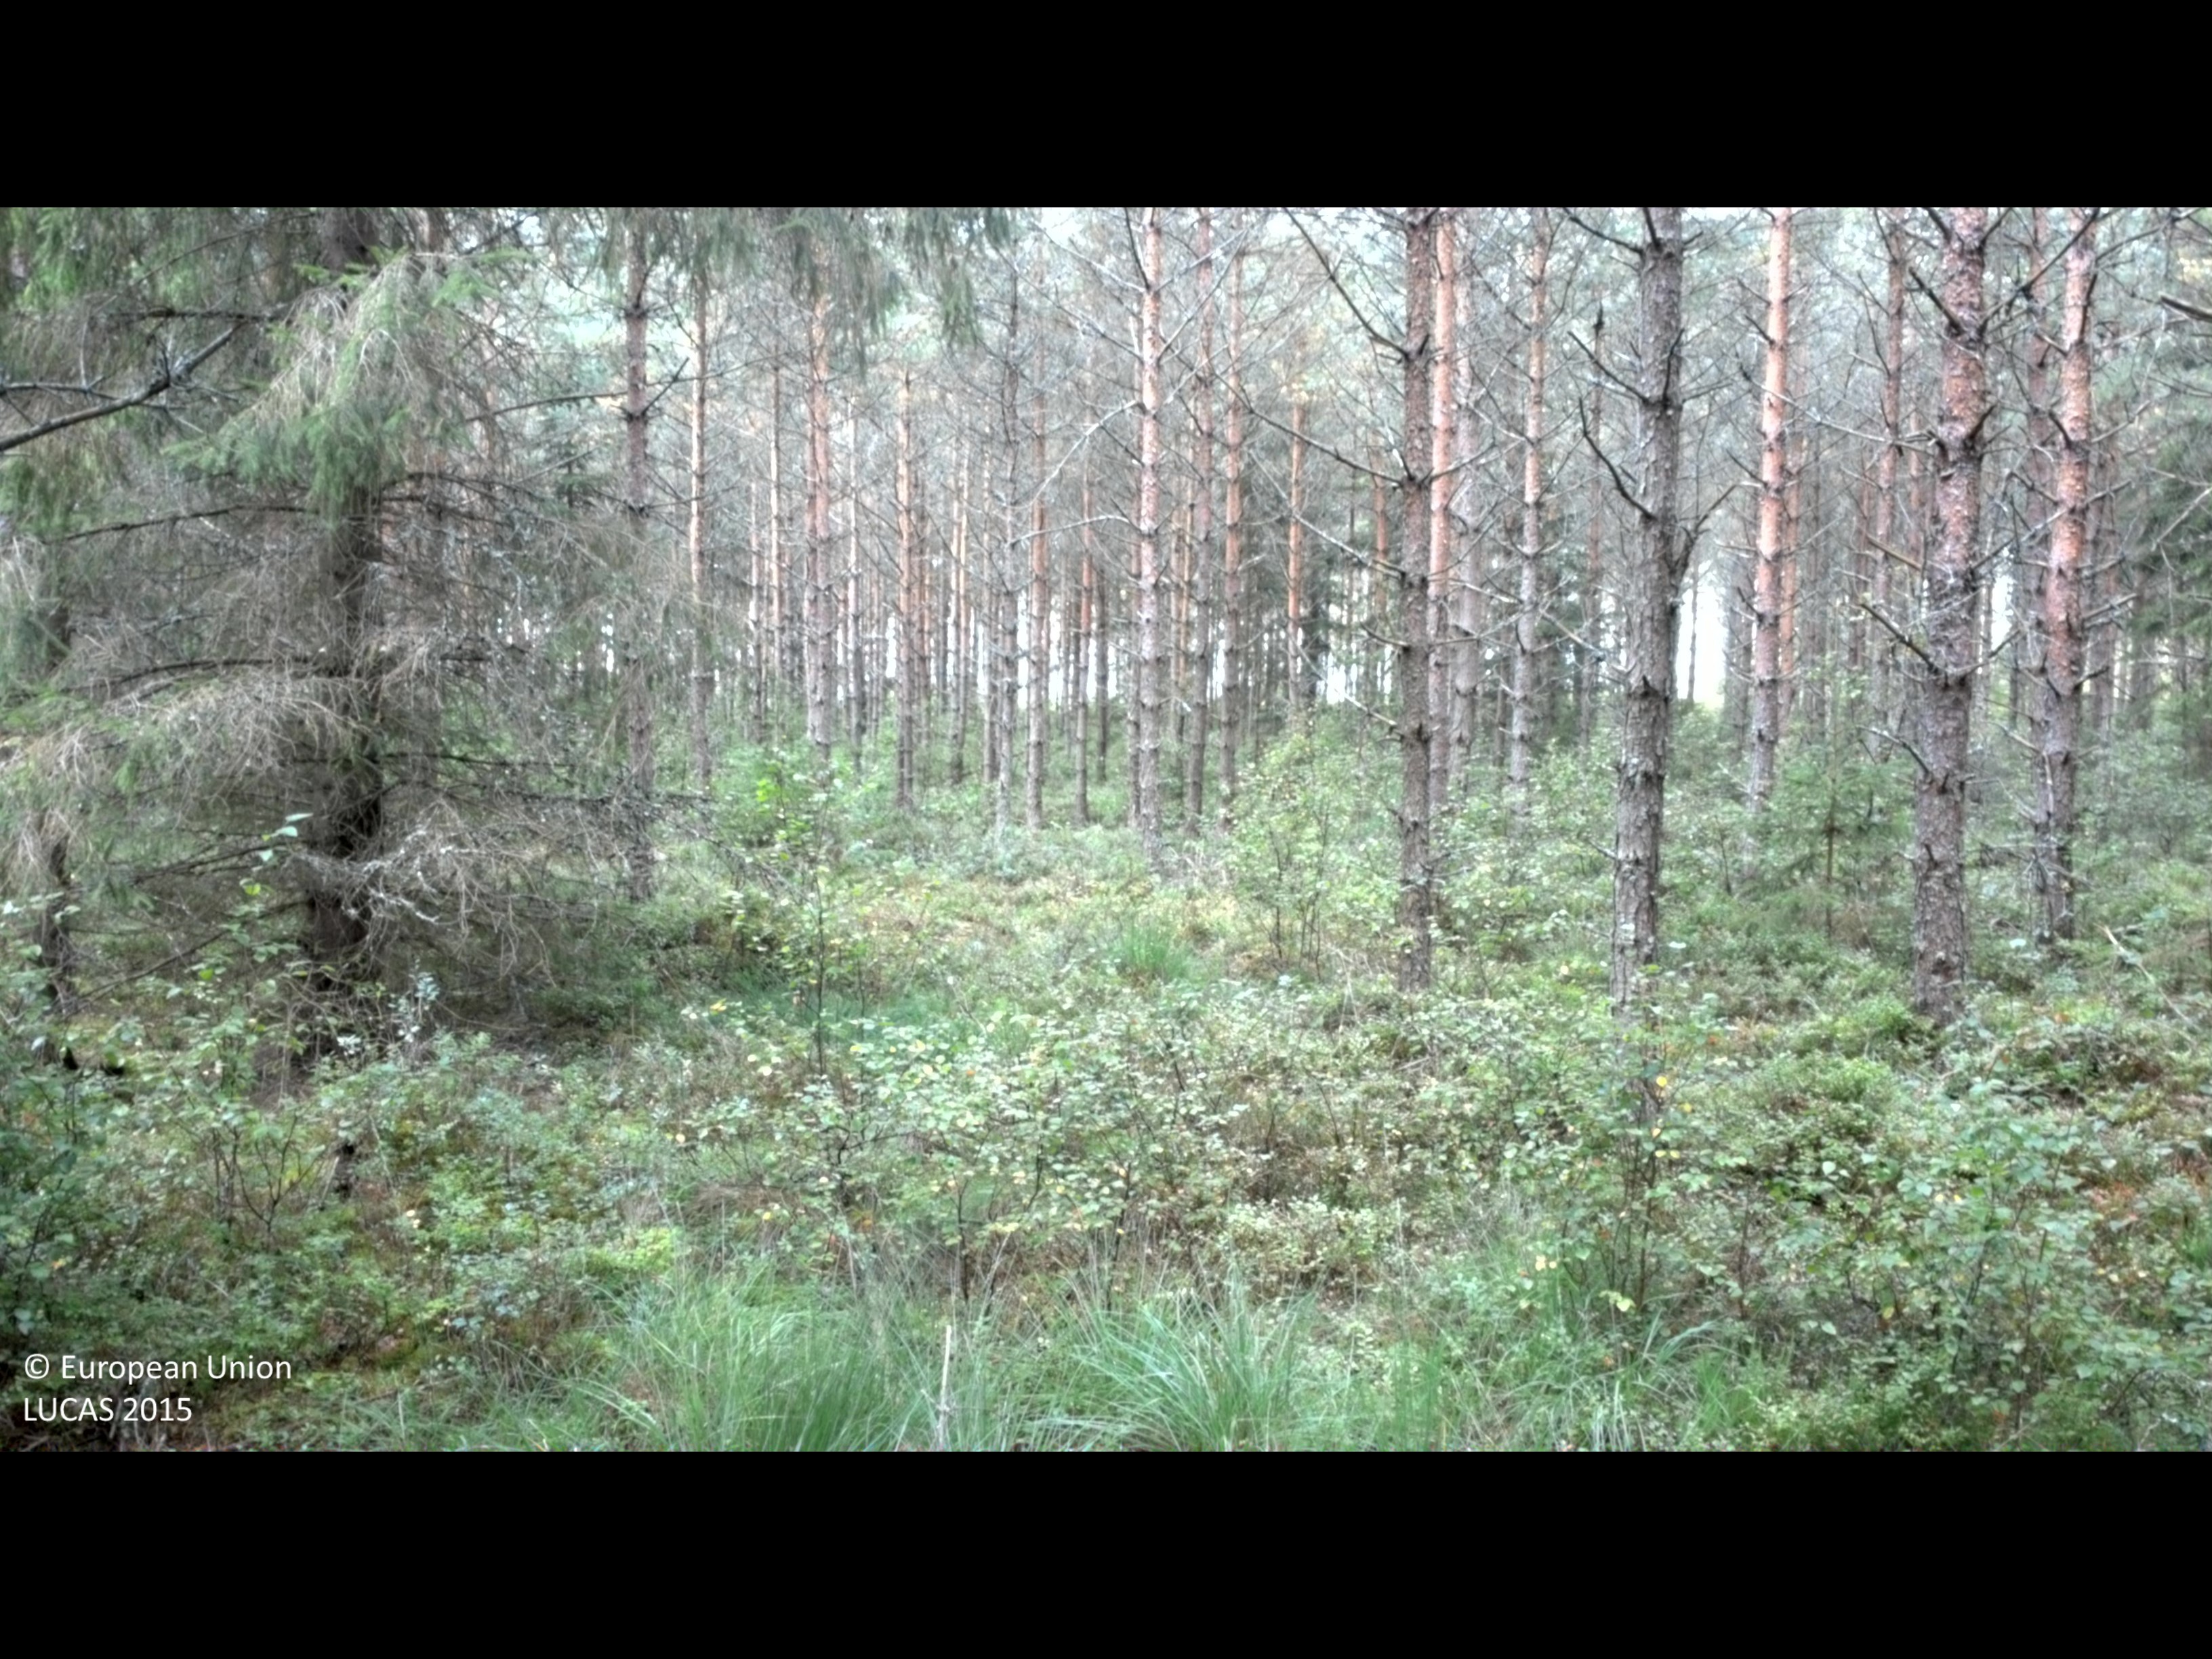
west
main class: Woodland
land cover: Pine dominated coniferous woodland
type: boreal forest
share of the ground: 50 - 75 %
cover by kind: coniferous forest trees 60 %, shrubs 20 %, herbaceous plants 15 %, broadleaved forest trees 5 %
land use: Forestry
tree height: > 5 m
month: August
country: SE
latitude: 57.1392
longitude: 13.8132
